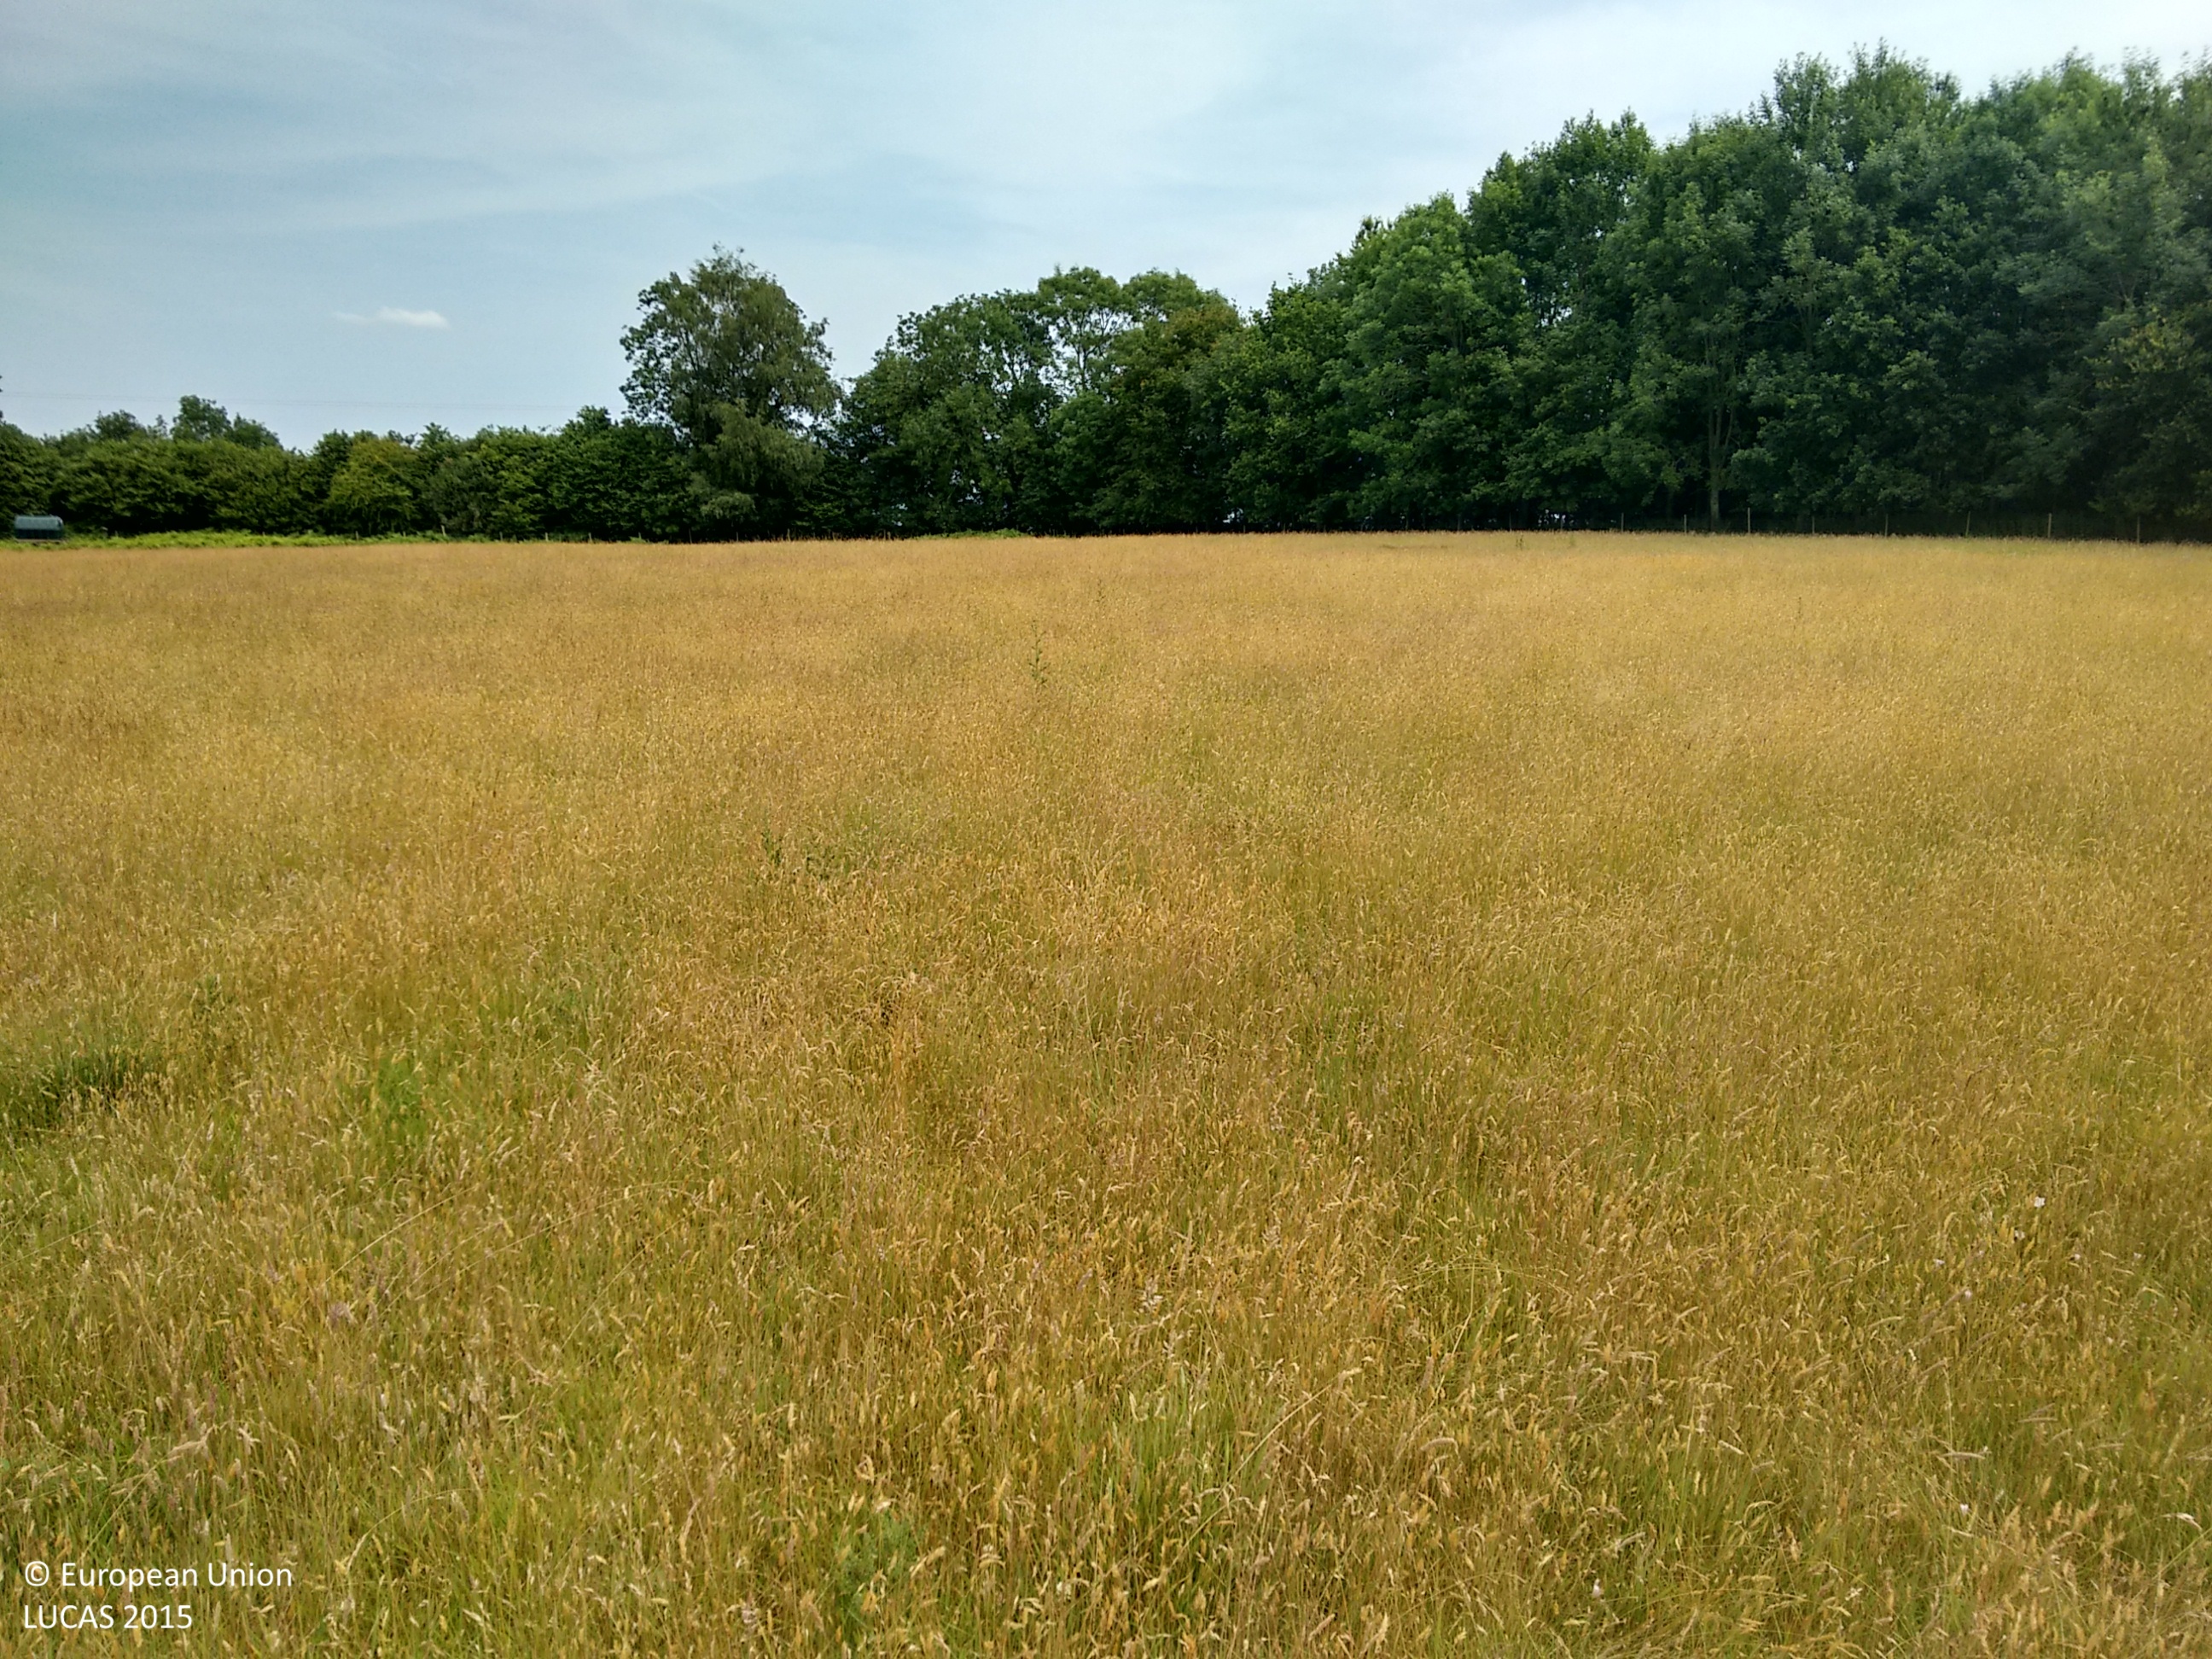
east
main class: Grassland
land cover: Grassland without tree/shrub cover
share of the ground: > 75 %
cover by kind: herbaceous plants 100 %
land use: Agriculture (excluding fallow land and kitchen gardens)
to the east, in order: Grassland without tree/shrub cover; Fences; Broadleaved woodland; Electric lines; Paved roads, cycling and walking lanes; Groves; Fences; Grass margins; Vineyards
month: July
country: GB
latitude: 50.9697
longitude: -0.4762
